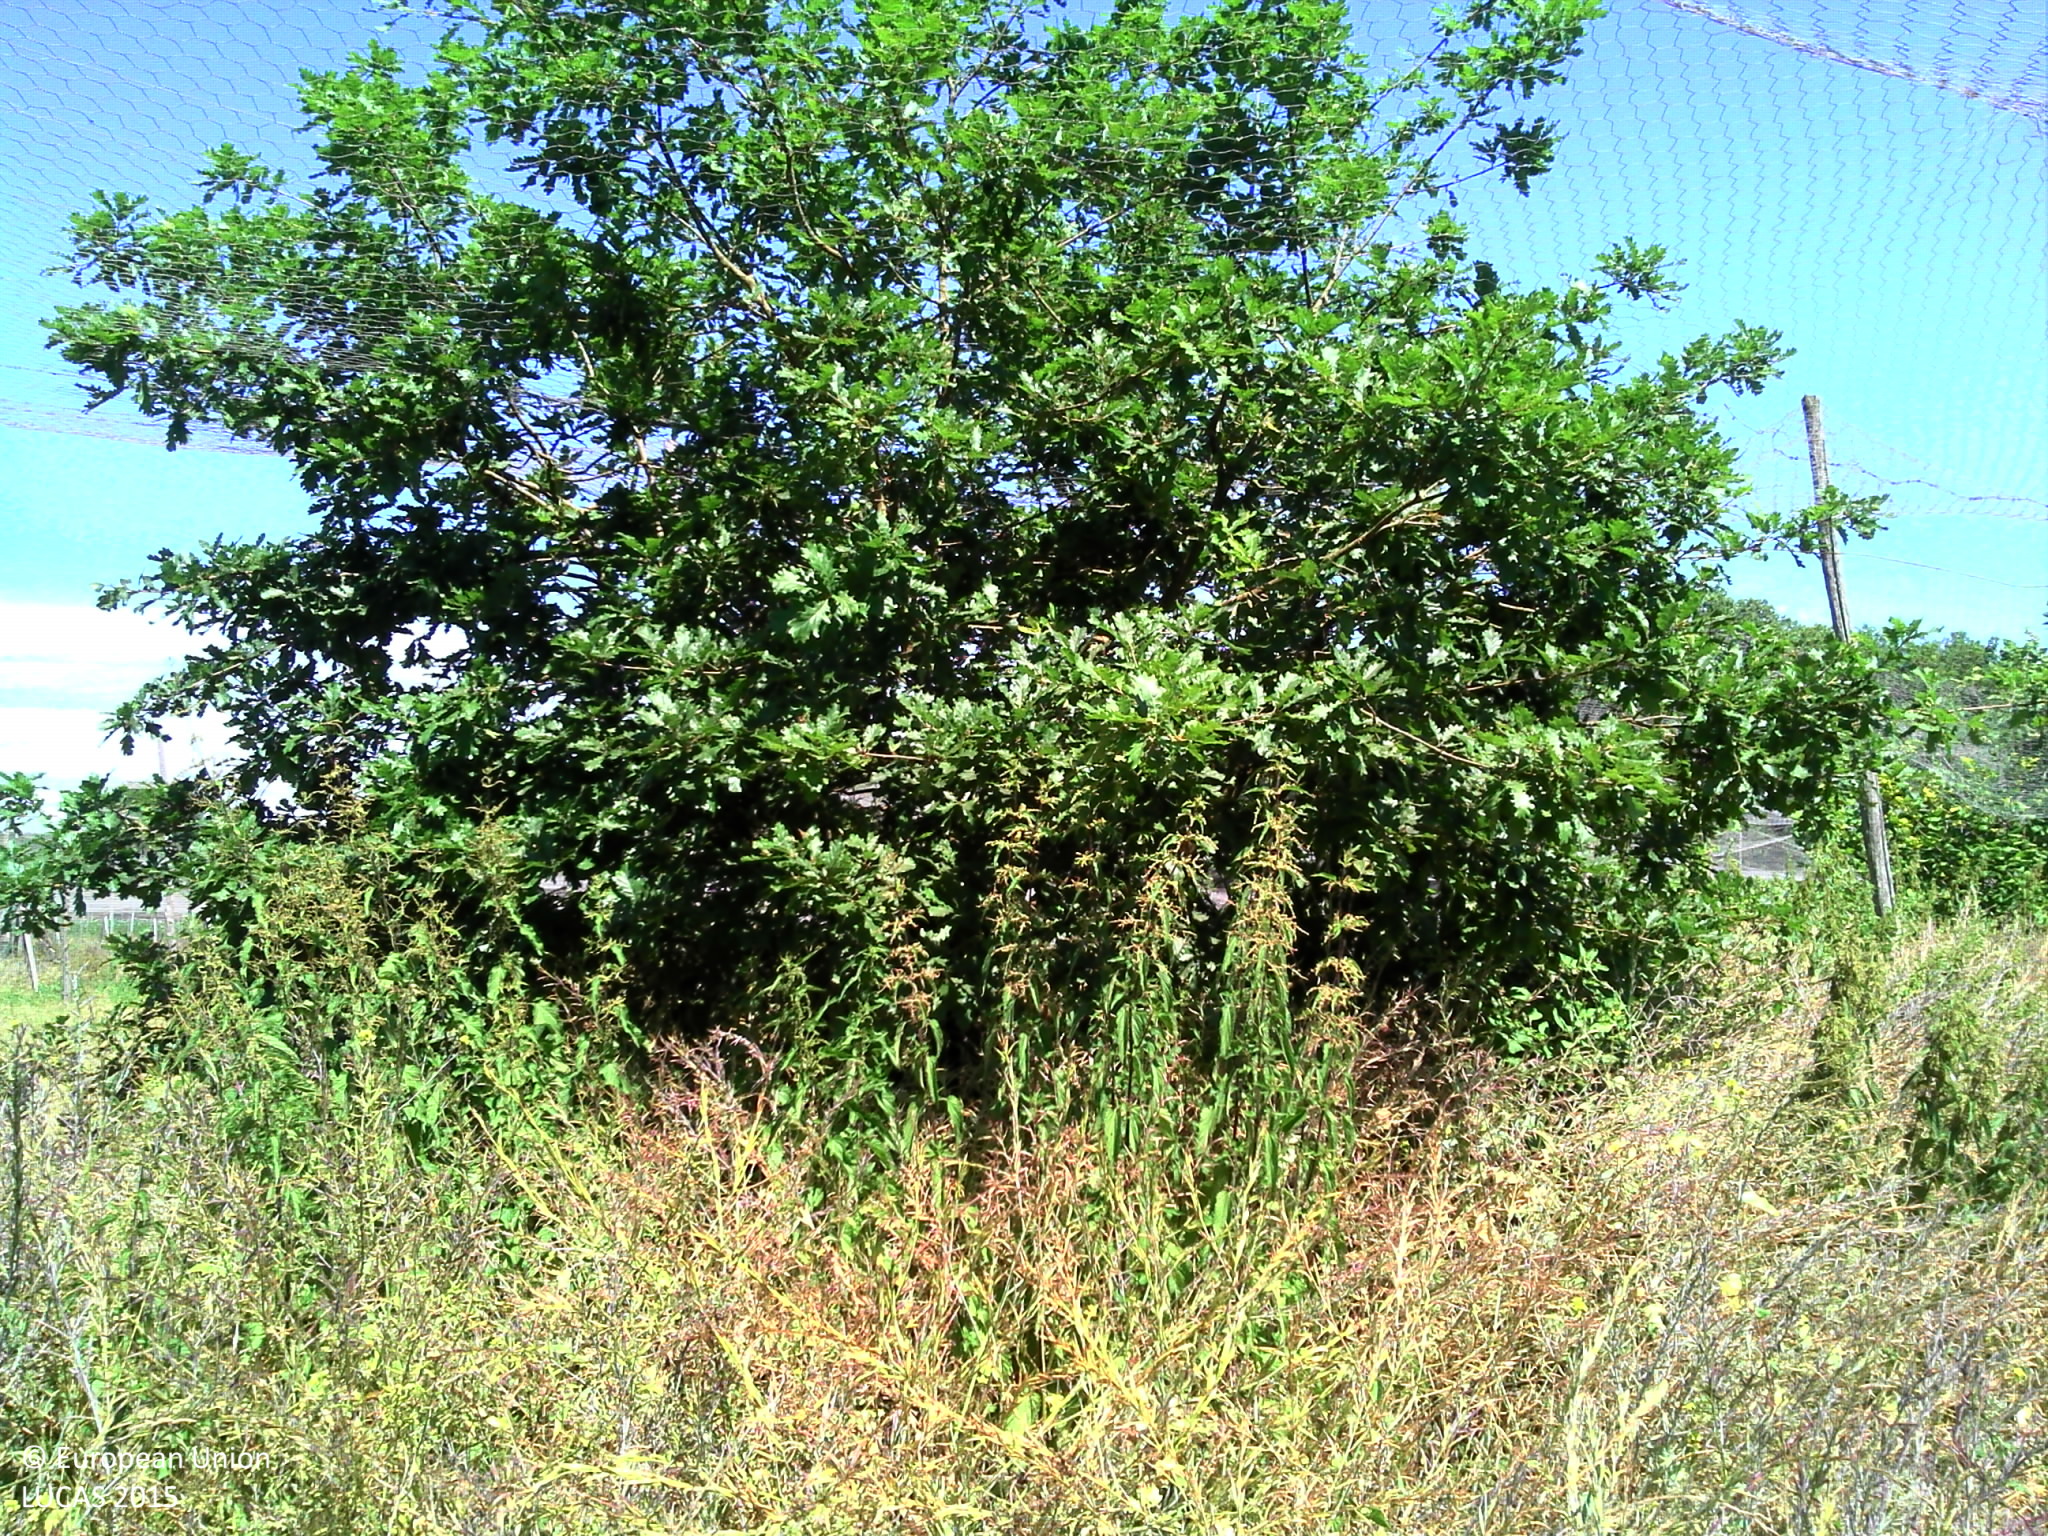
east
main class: Grassland
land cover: Grassland with sparse tree/shrub cover
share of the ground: > 75 %
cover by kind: herbaceous plants 95 %, broadleaved forest trees 5 %
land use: Agriculture (excluding fallow land and kitchen gardens)
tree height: < 5 m
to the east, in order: Grassland with sparse tree/shrub cover; Fences; Grassland with sparse tree/shrub cover; Fences; Broadleaved woodland; Grassland without tree/shrub cover; Broadleaved woodland
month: June
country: FR
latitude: 45.5596
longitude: 0.4420
